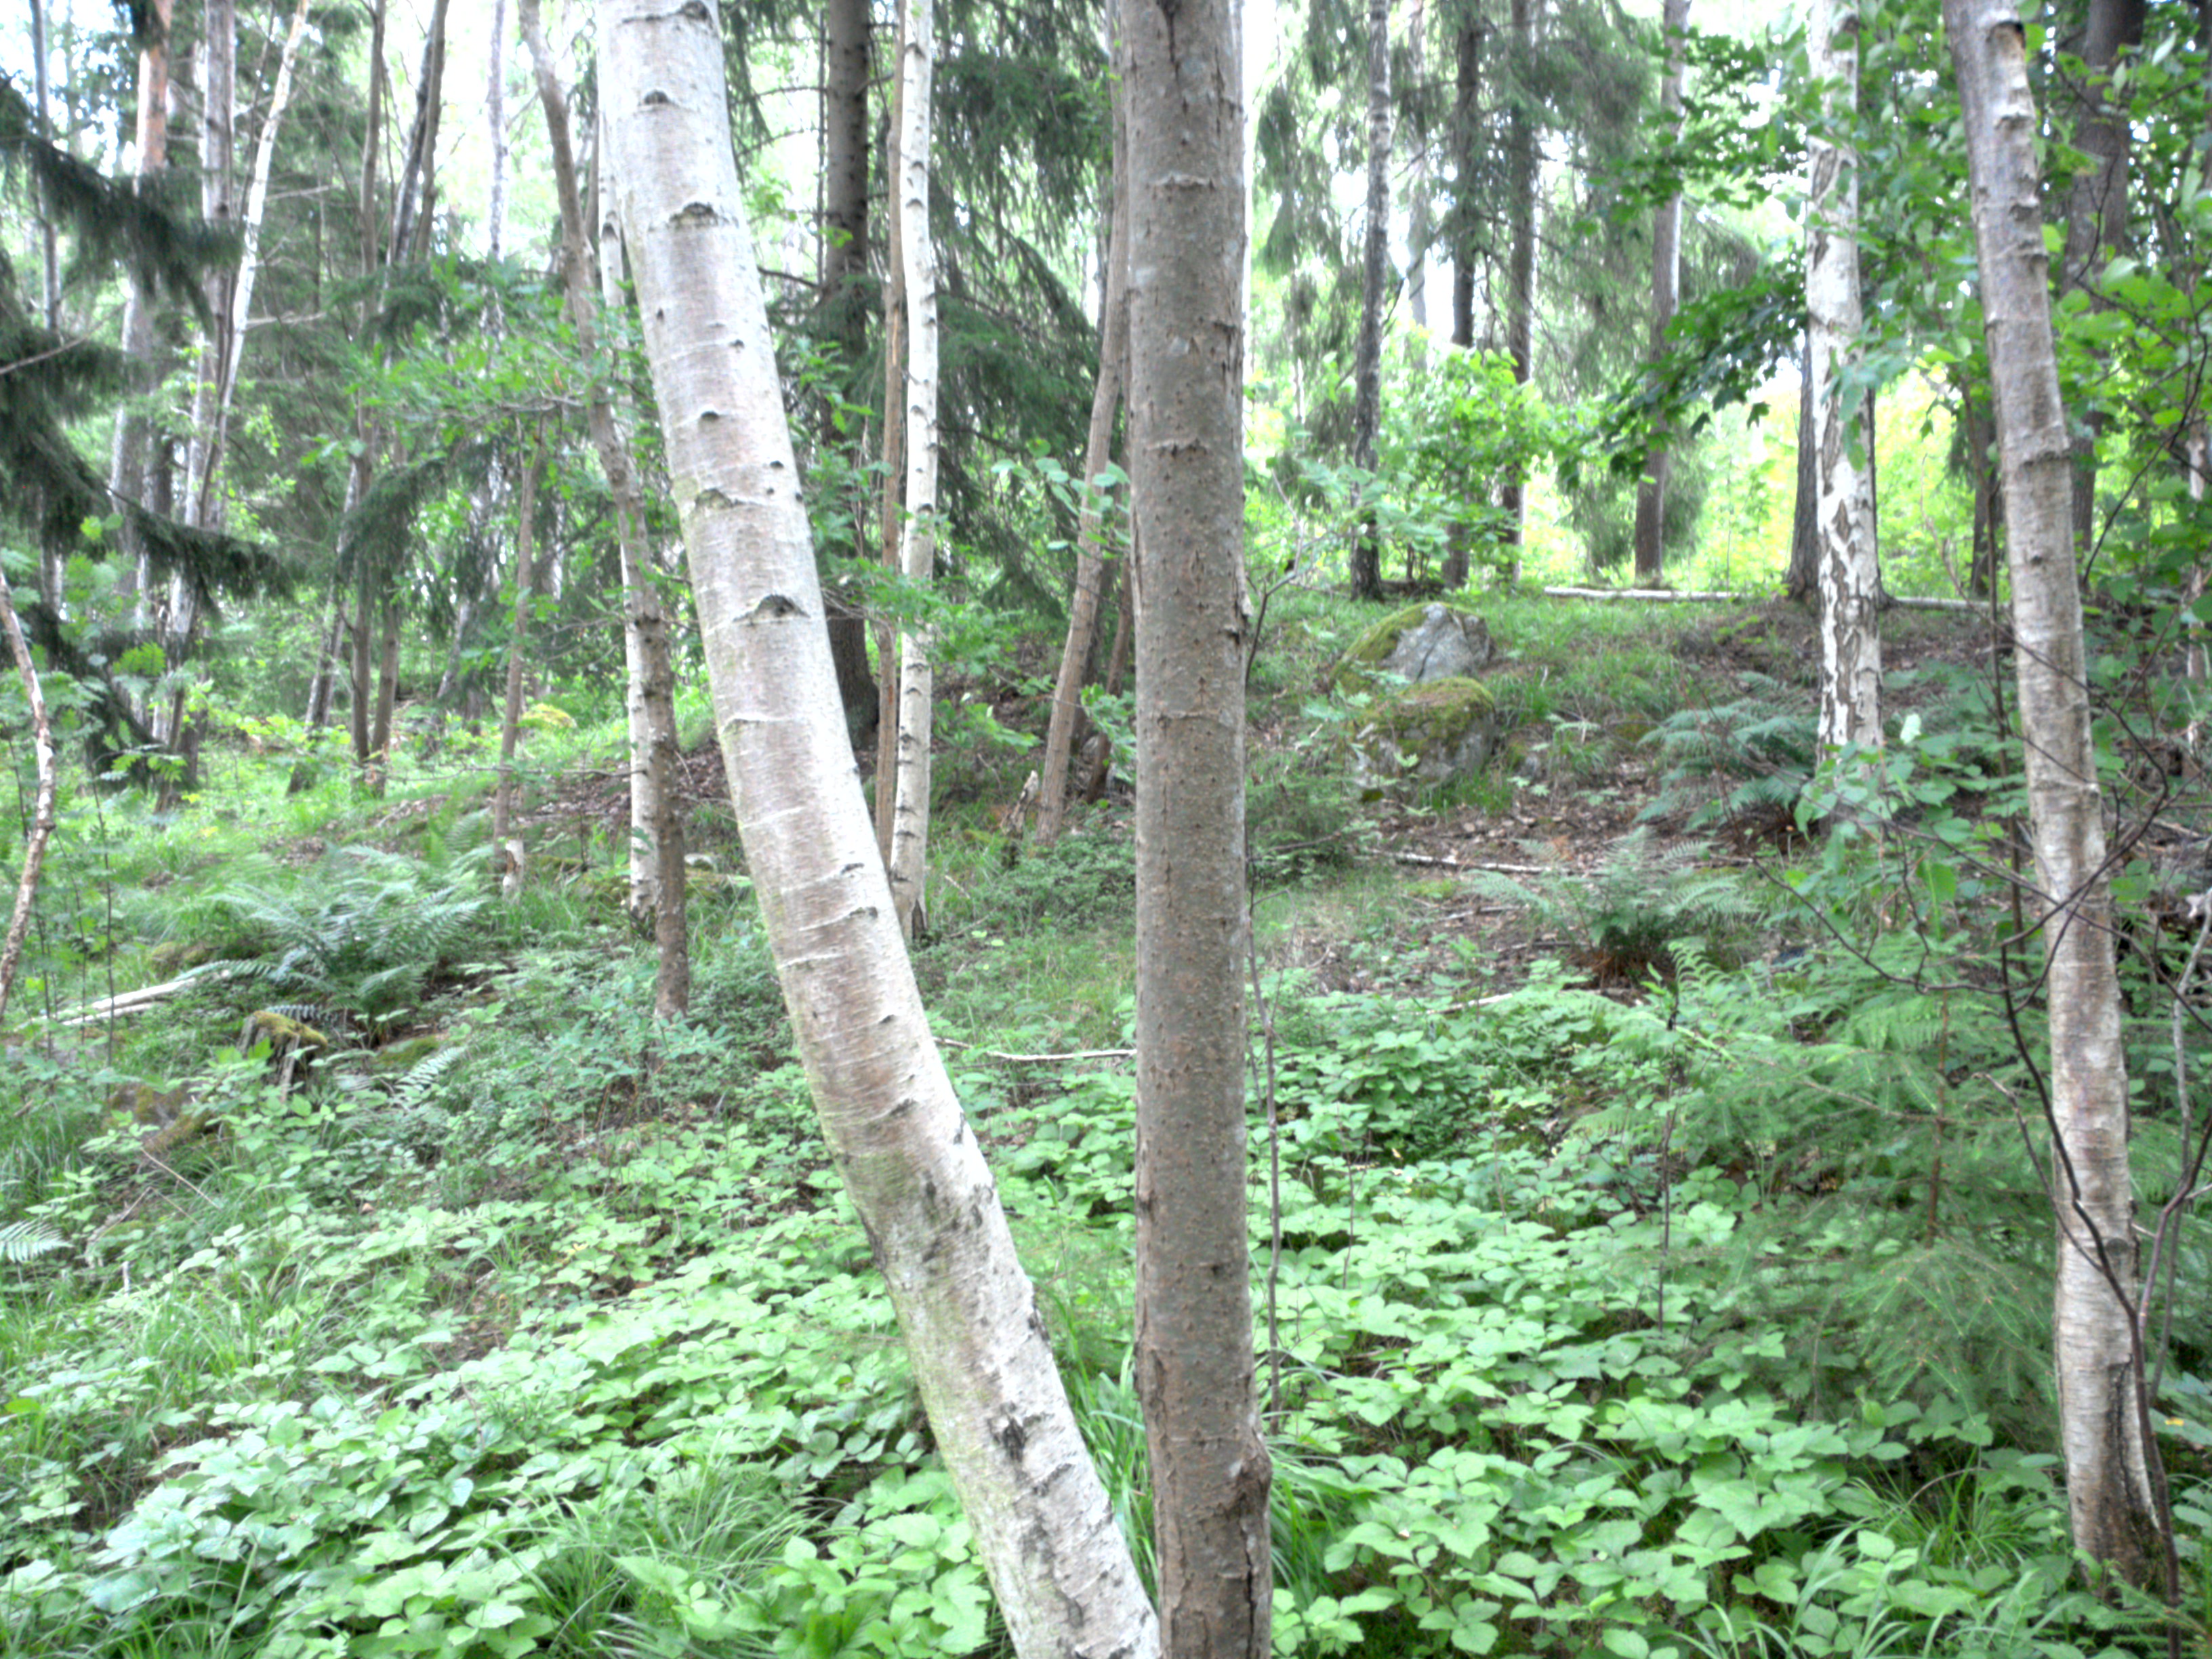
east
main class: Woodland
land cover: Broadleaved woodland
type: non-riverine alder, birch or aspen forest
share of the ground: 50 - 75 %
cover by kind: broadleaved forest trees 70 %, coniferous forest trees 10 %, shrubs 10 %, herbaceous plants 5 %, lichens and mosses 5 %
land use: Forestry
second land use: Amenities, museums, leisure
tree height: > 5 m
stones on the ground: < 10 %
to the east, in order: Broadleaved woodland; Paved roads, cycling and walking lanes; Broadleaved woodland; Spruce dominated coniferous woodland; Broadleaved woodland; Artificial constructions in urban areas
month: June
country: SE
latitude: 59.2071
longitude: 17.7559
